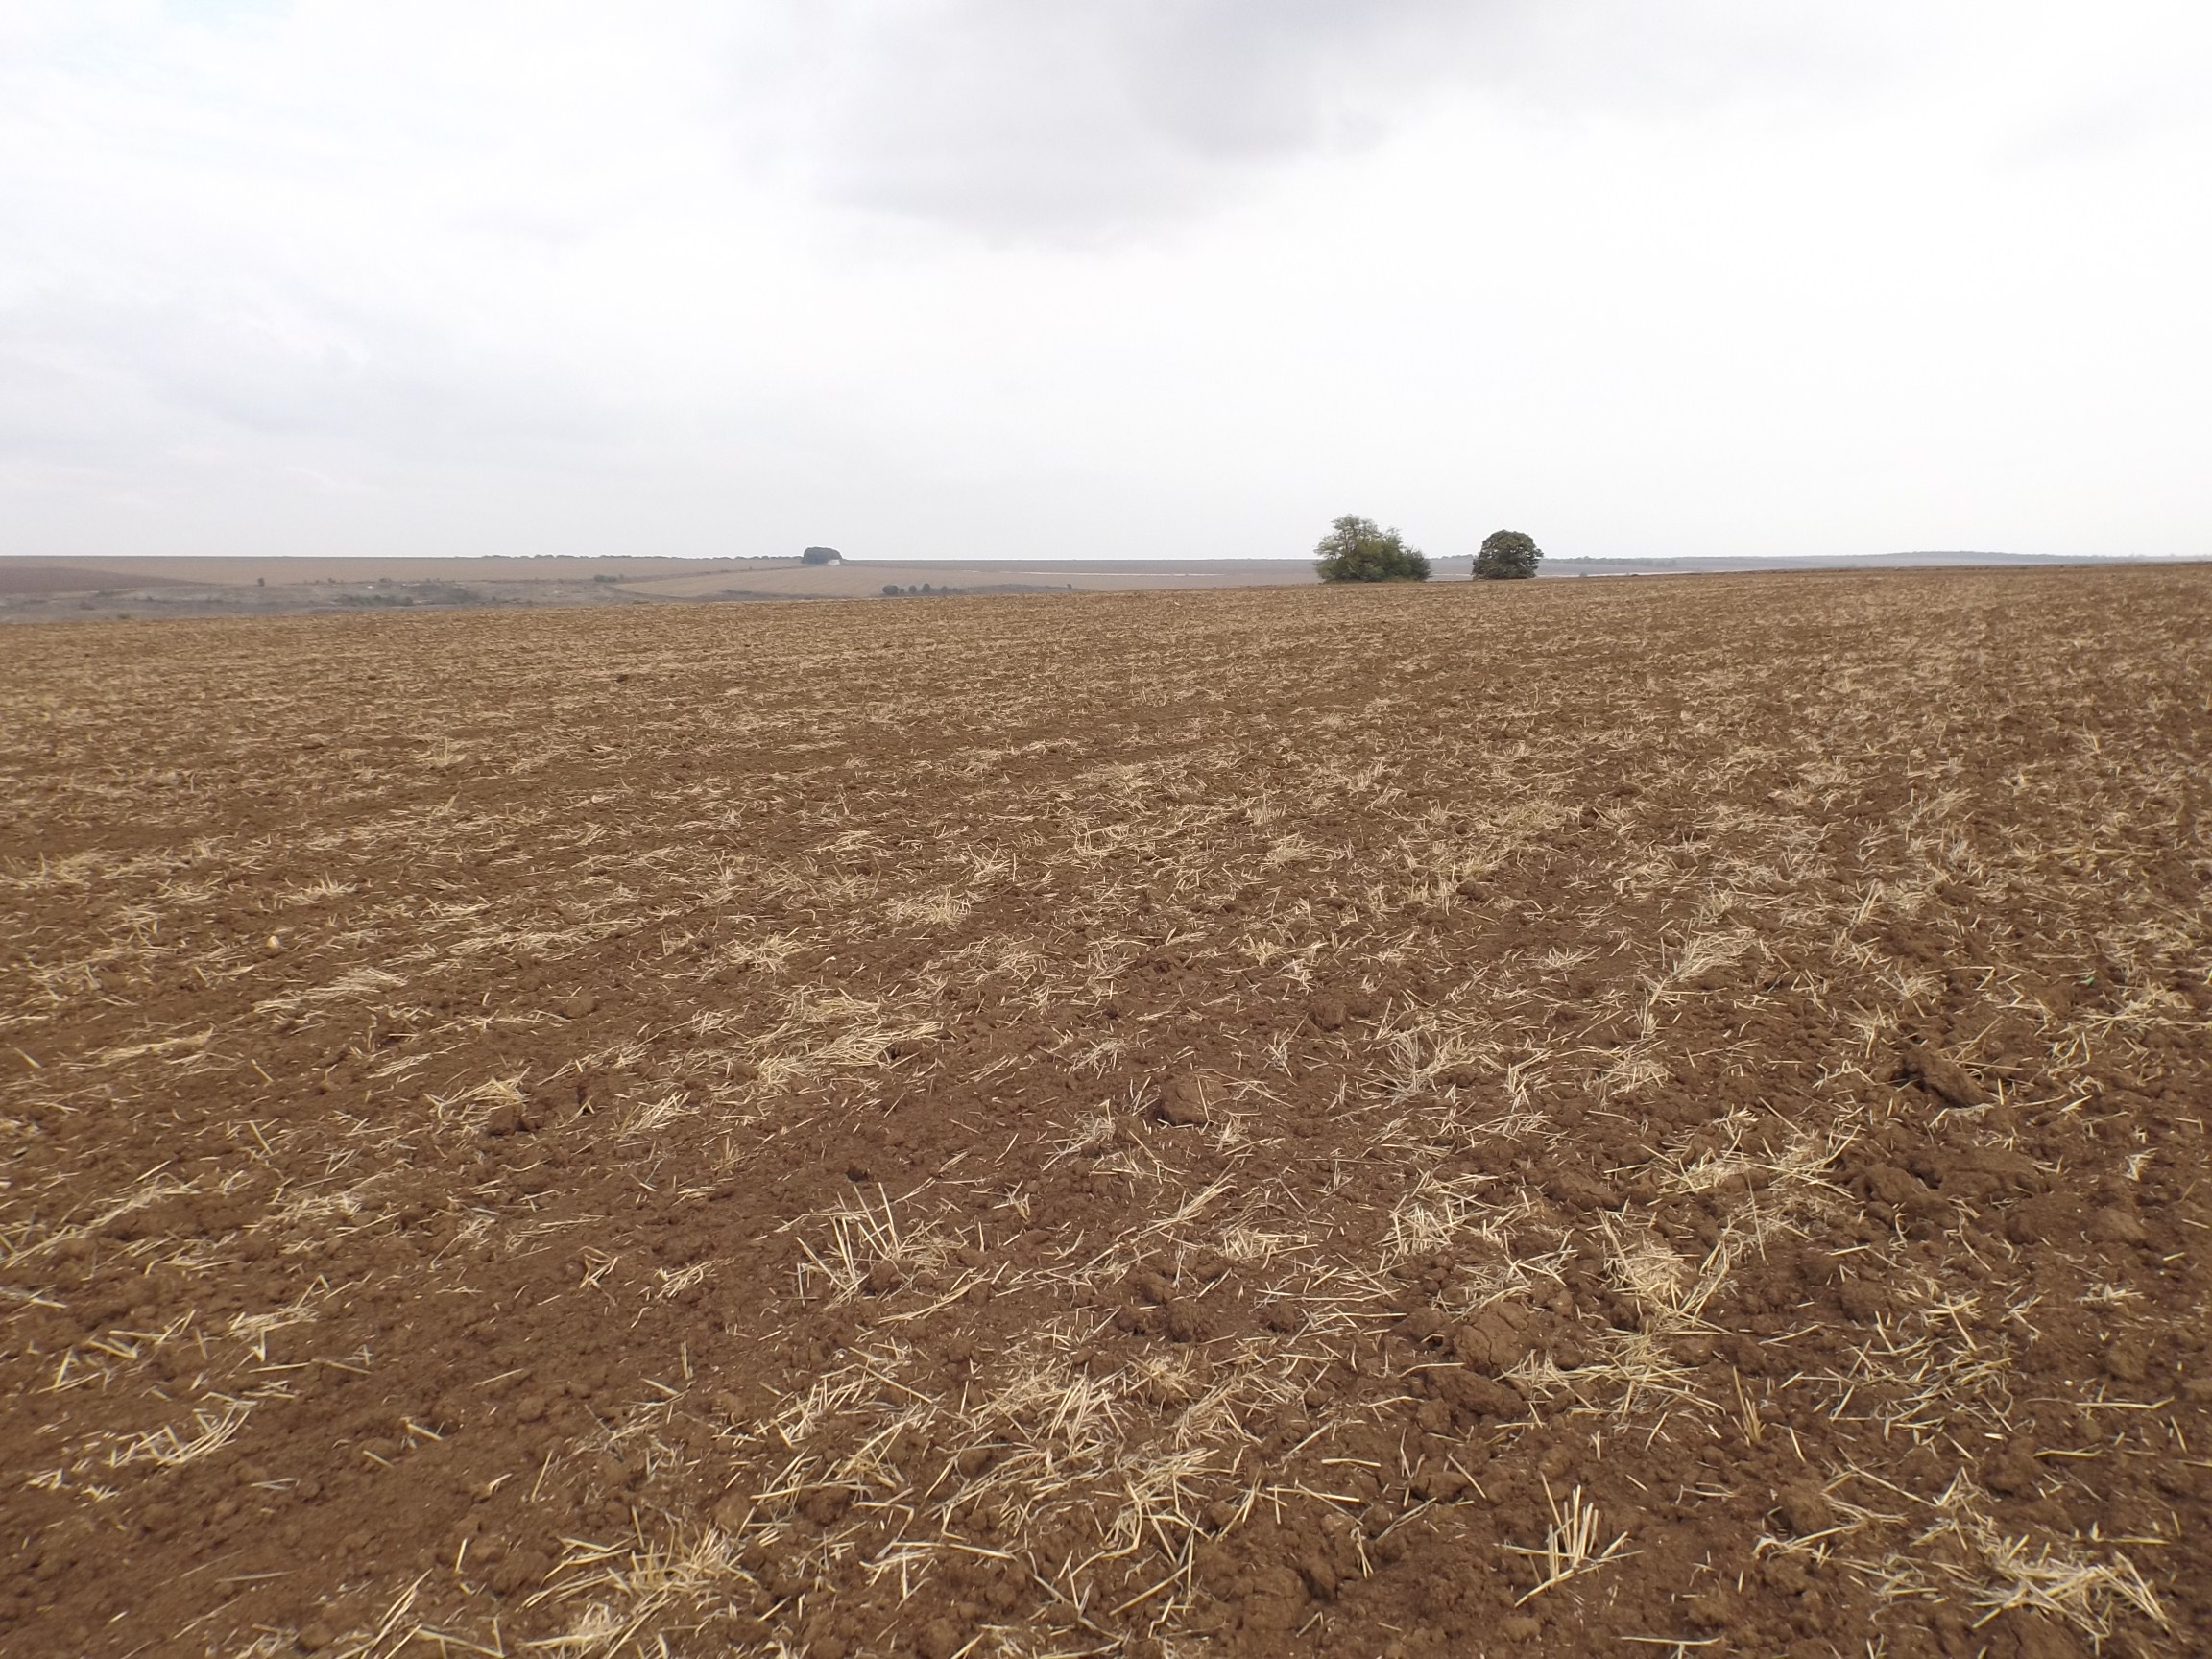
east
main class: Cropland
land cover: Common wheat
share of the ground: < 10 %
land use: Agriculture (excluding fallow land and kitchen gardens)
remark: Harvested field
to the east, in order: Common wheat; Tracks; Soya
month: September
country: BG
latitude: 43.4292
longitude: 27.7656
